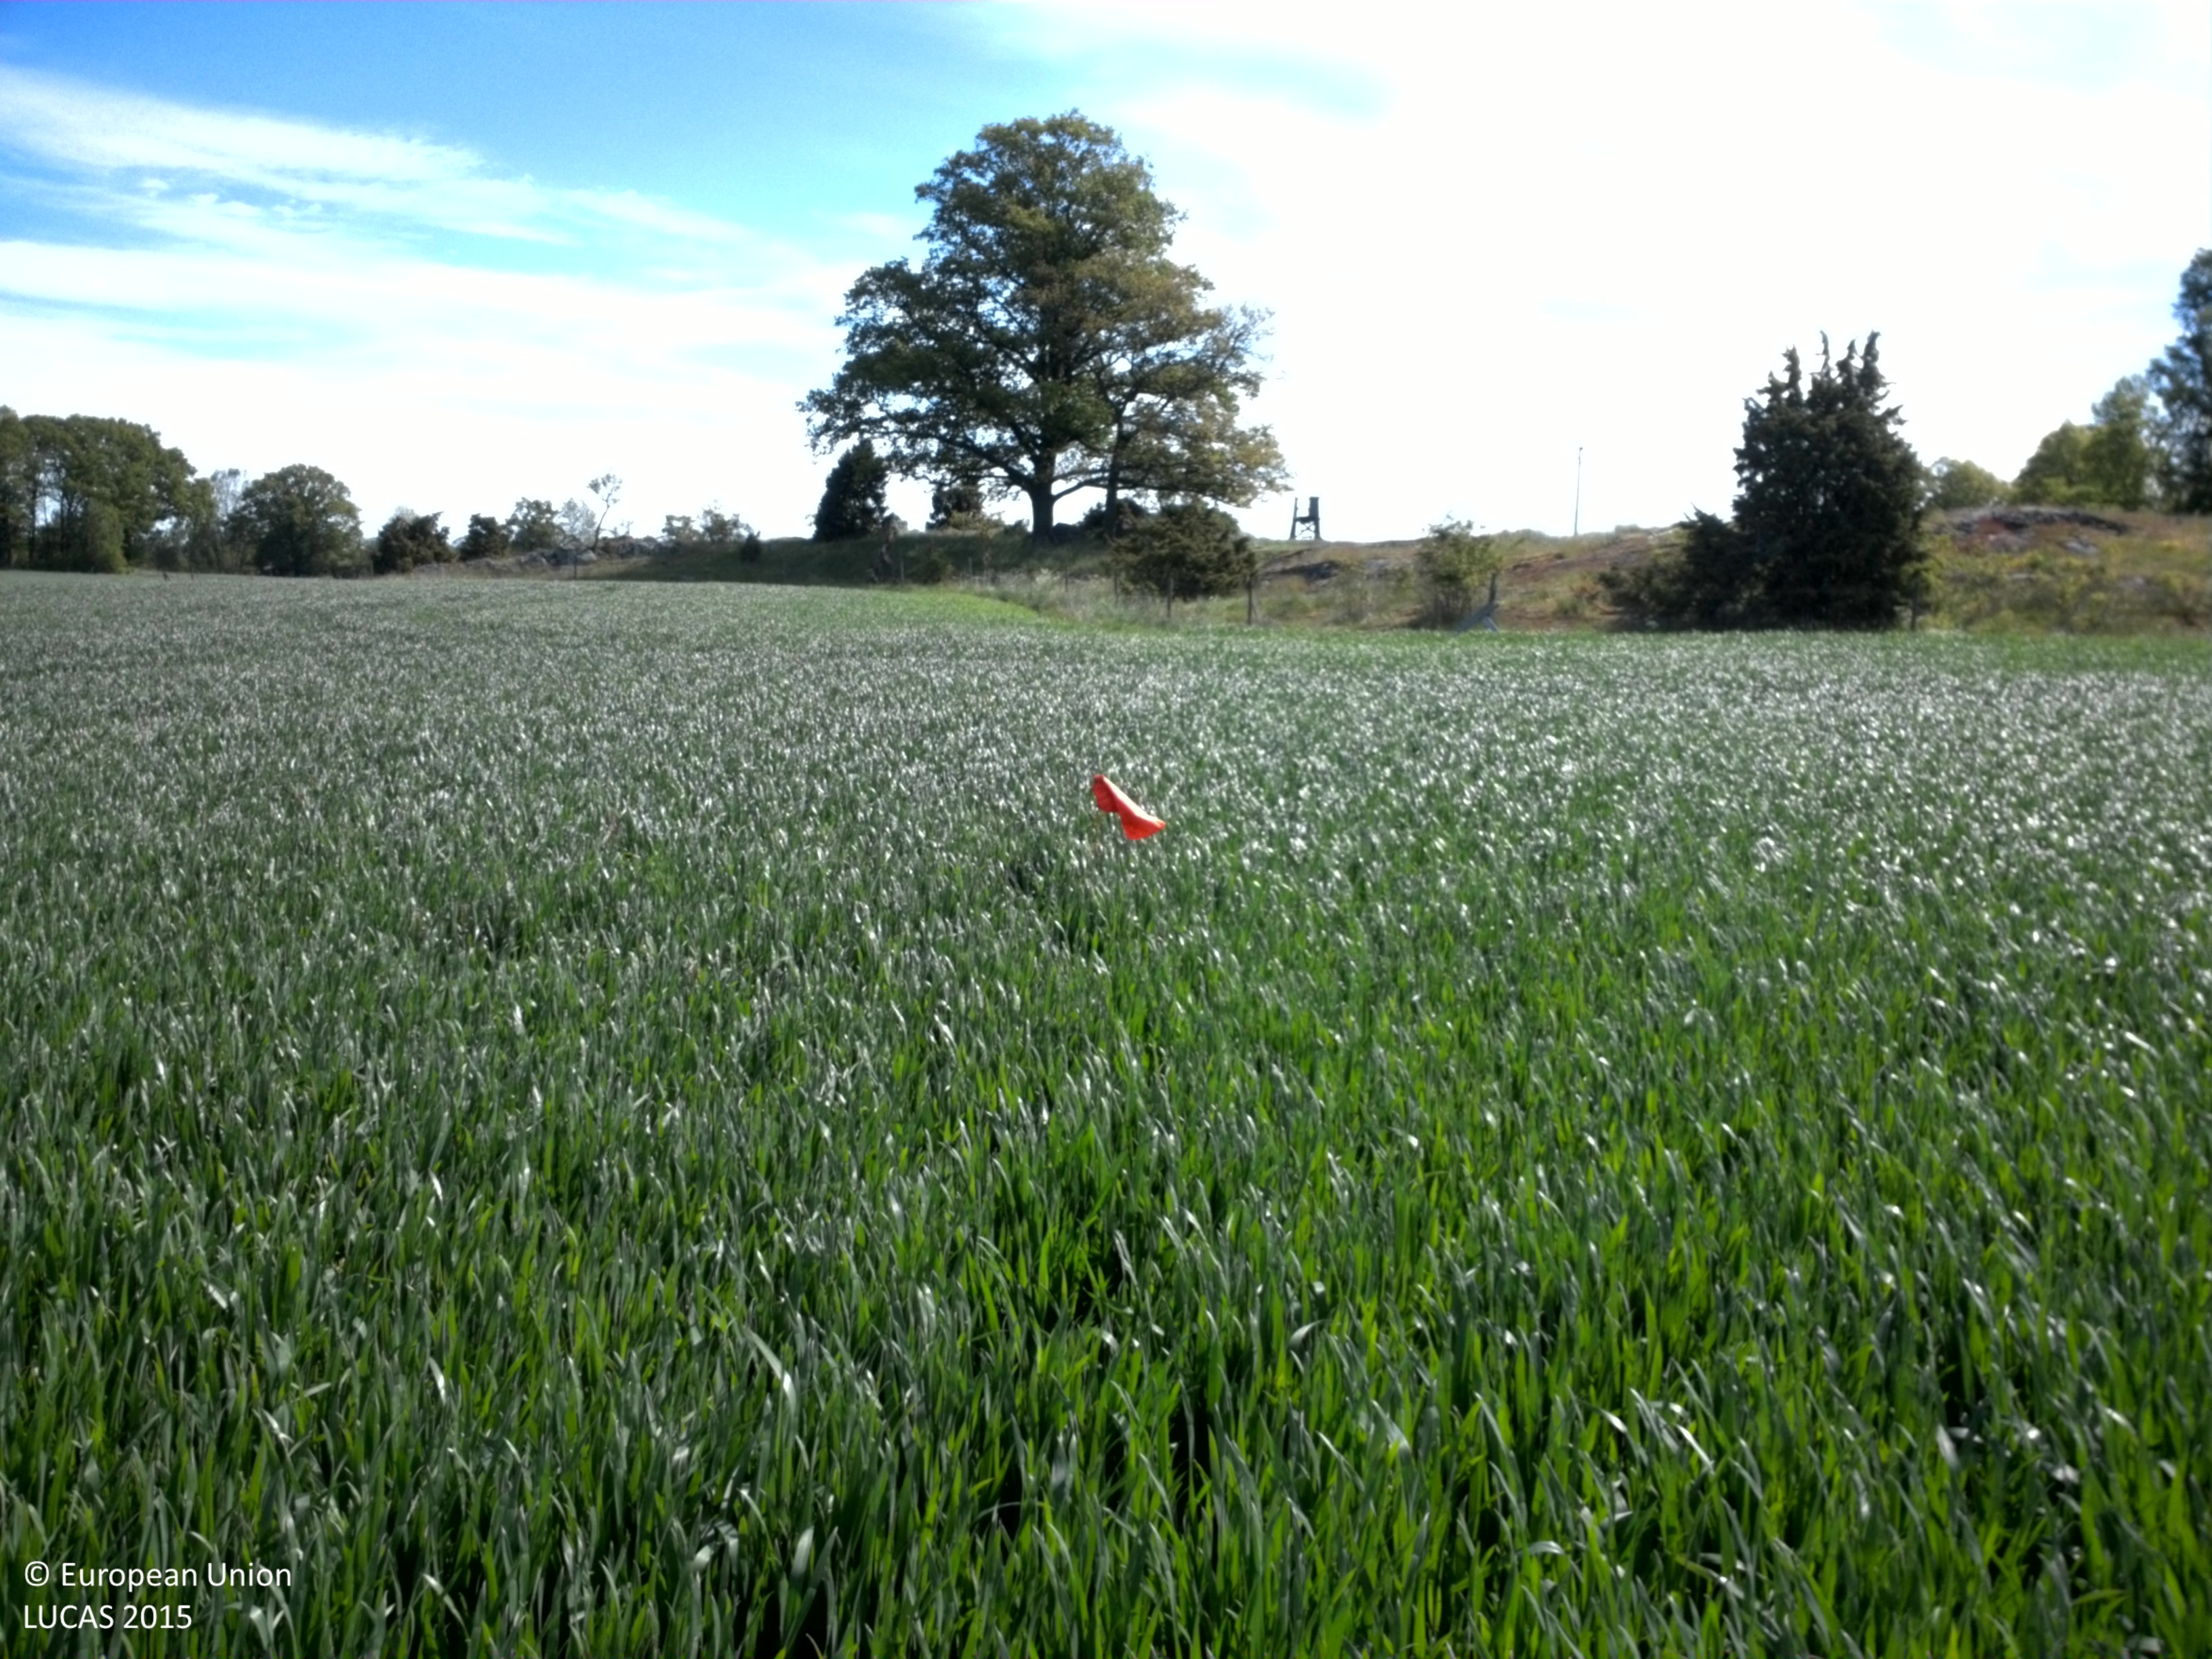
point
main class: Cropland
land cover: Barley
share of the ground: > 75 %
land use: Agriculture (excluding fallow land and kitchen gardens)
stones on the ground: < 10 %
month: June
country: SE
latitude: 58.4773
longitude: 15.7048
